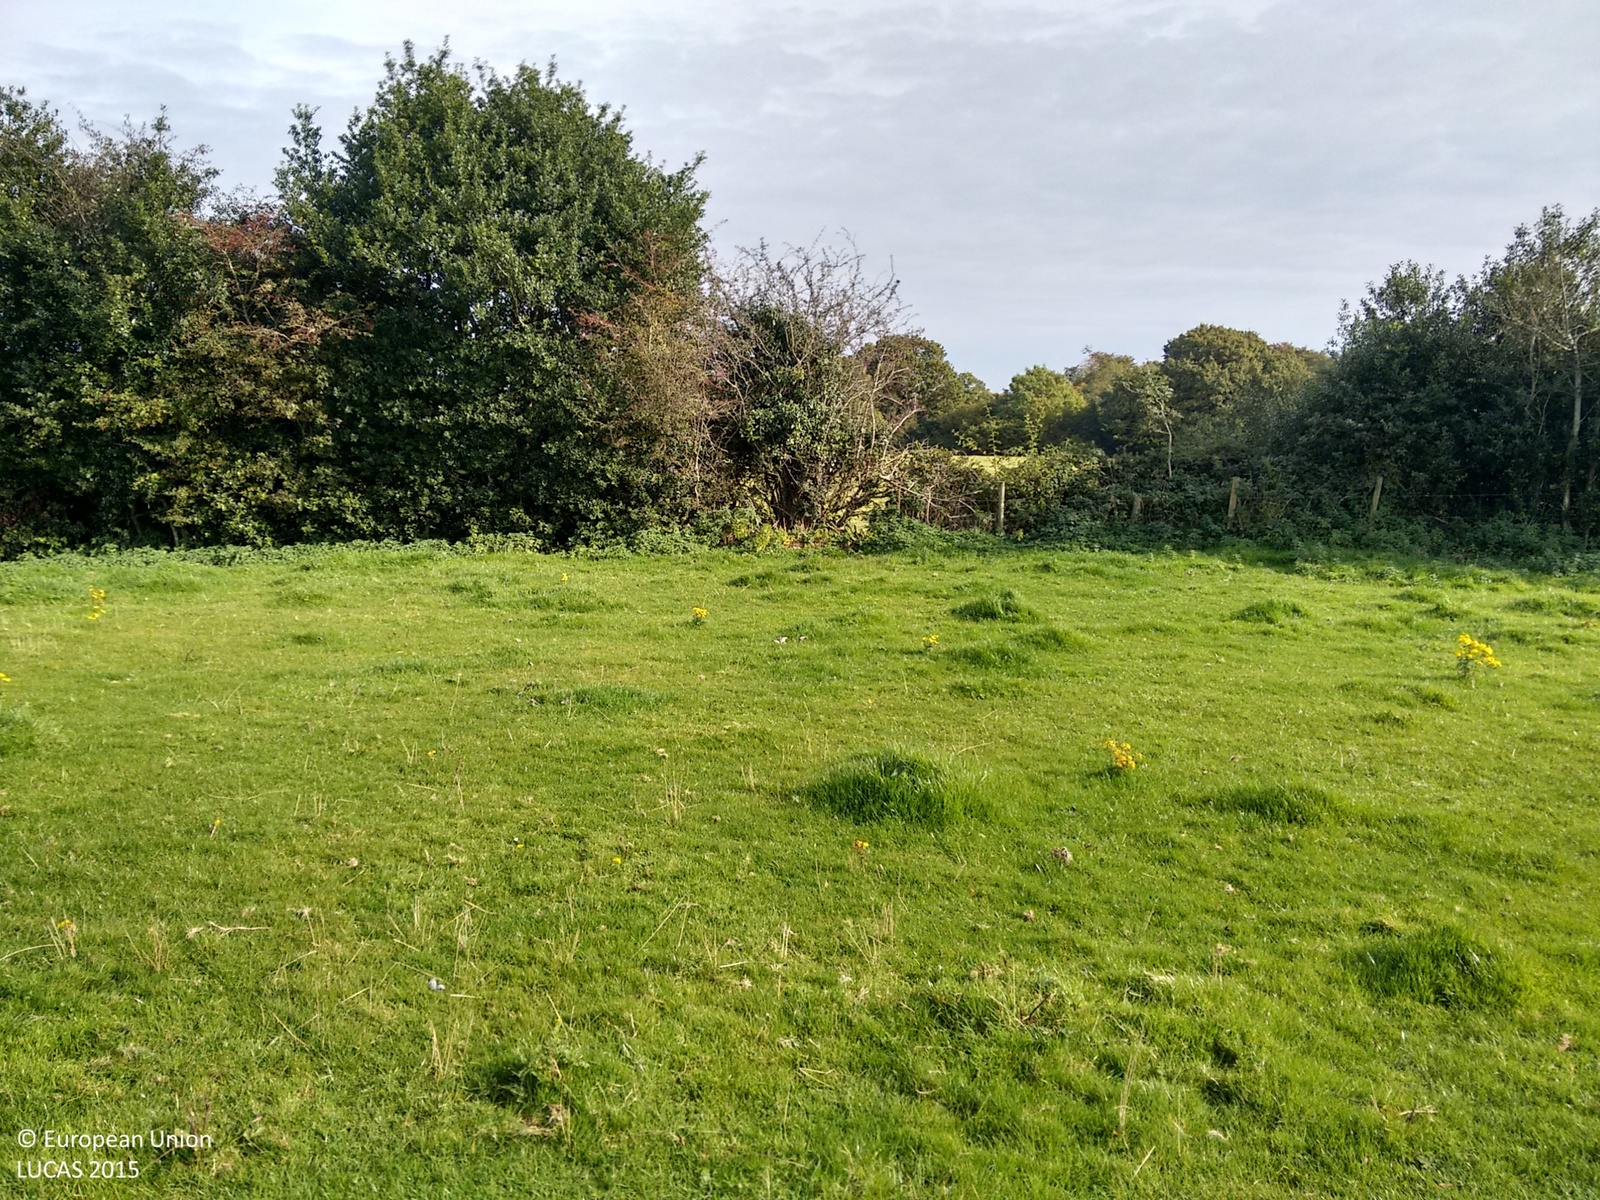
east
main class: Grassland
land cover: Grassland without tree/shrub cover
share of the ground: > 75 %
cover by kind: herbaceous plants 100 %
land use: Agriculture (excluding fallow land and kitchen gardens)
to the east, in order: Grassland without tree/shrub cover; Fences; Abandoned hedges; Grassland without tree/shrub cover; Fences; Abandoned hedges; Grass margins; Artificial constructions in urban areas; Grass margins; Tracks; Grass margins
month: October
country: GB
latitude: 54.1837
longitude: -7.5819
